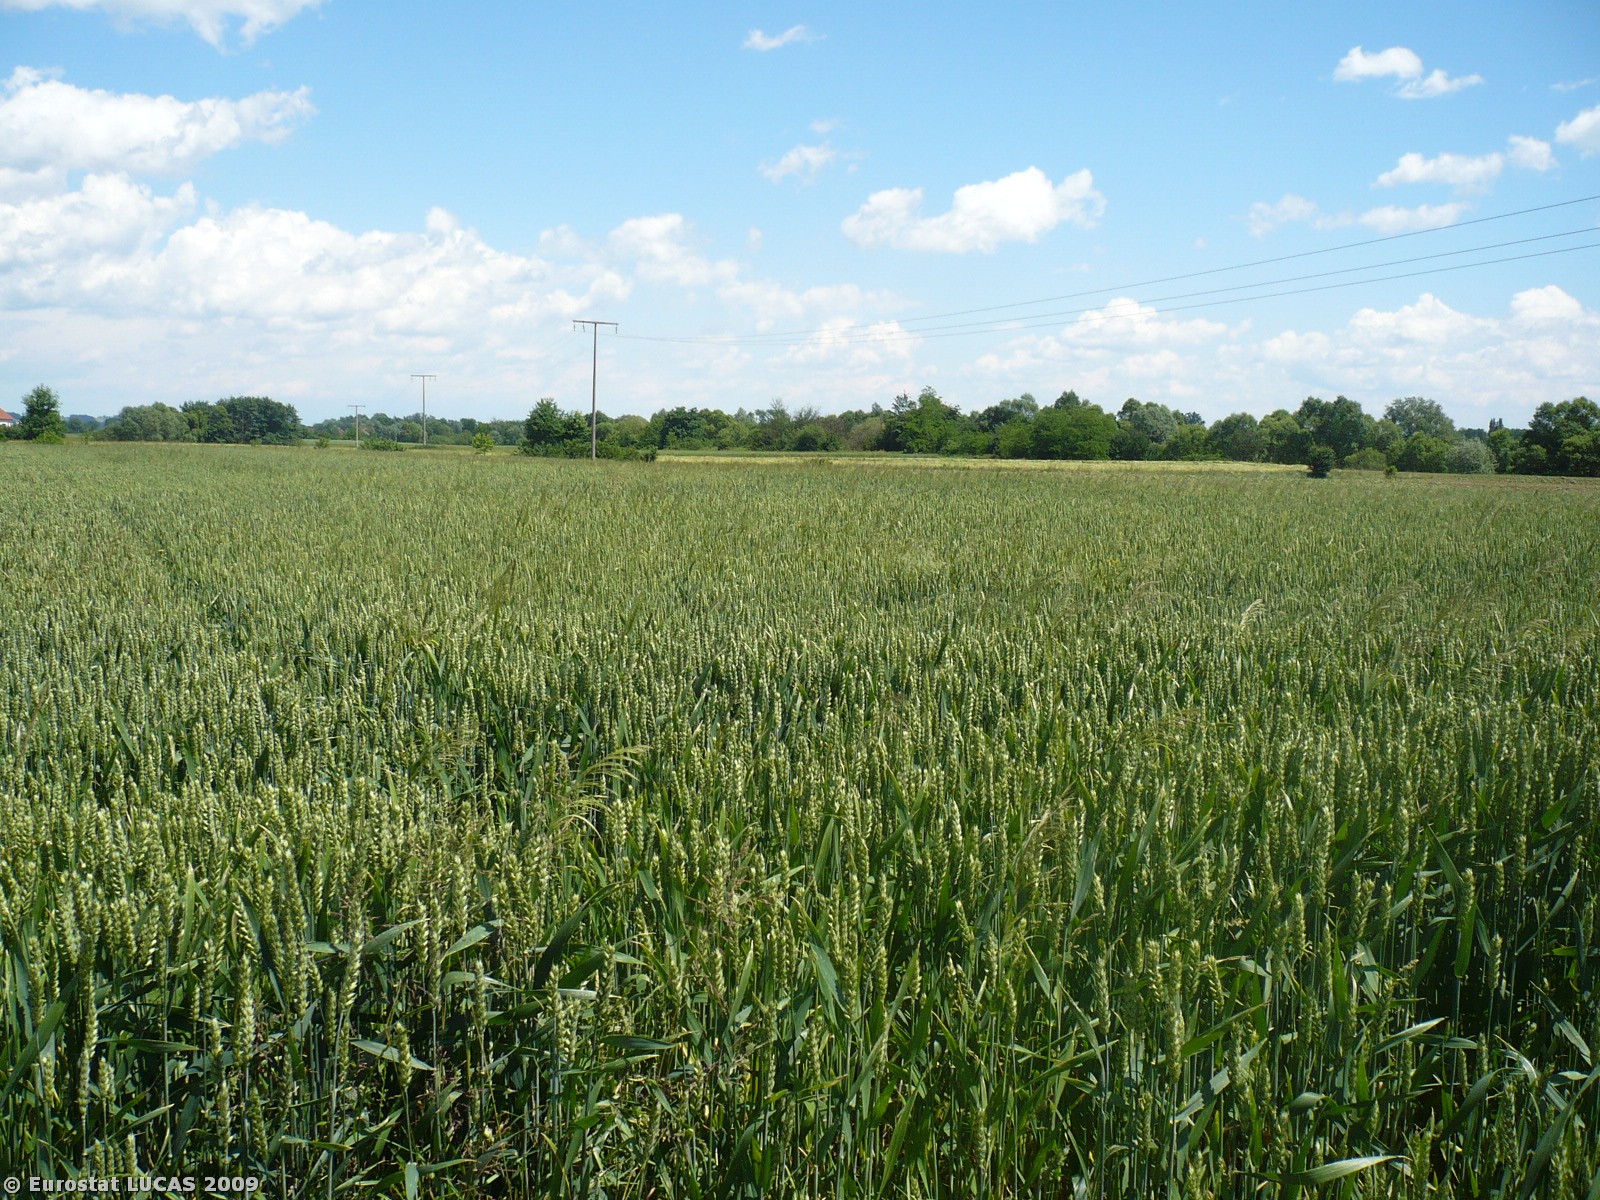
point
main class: Cropland
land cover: Common wheat
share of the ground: > 75 %
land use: Agriculture (excluding fallow land and kitchen gardens)
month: May
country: SI
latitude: 46.4162
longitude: 16.0234
